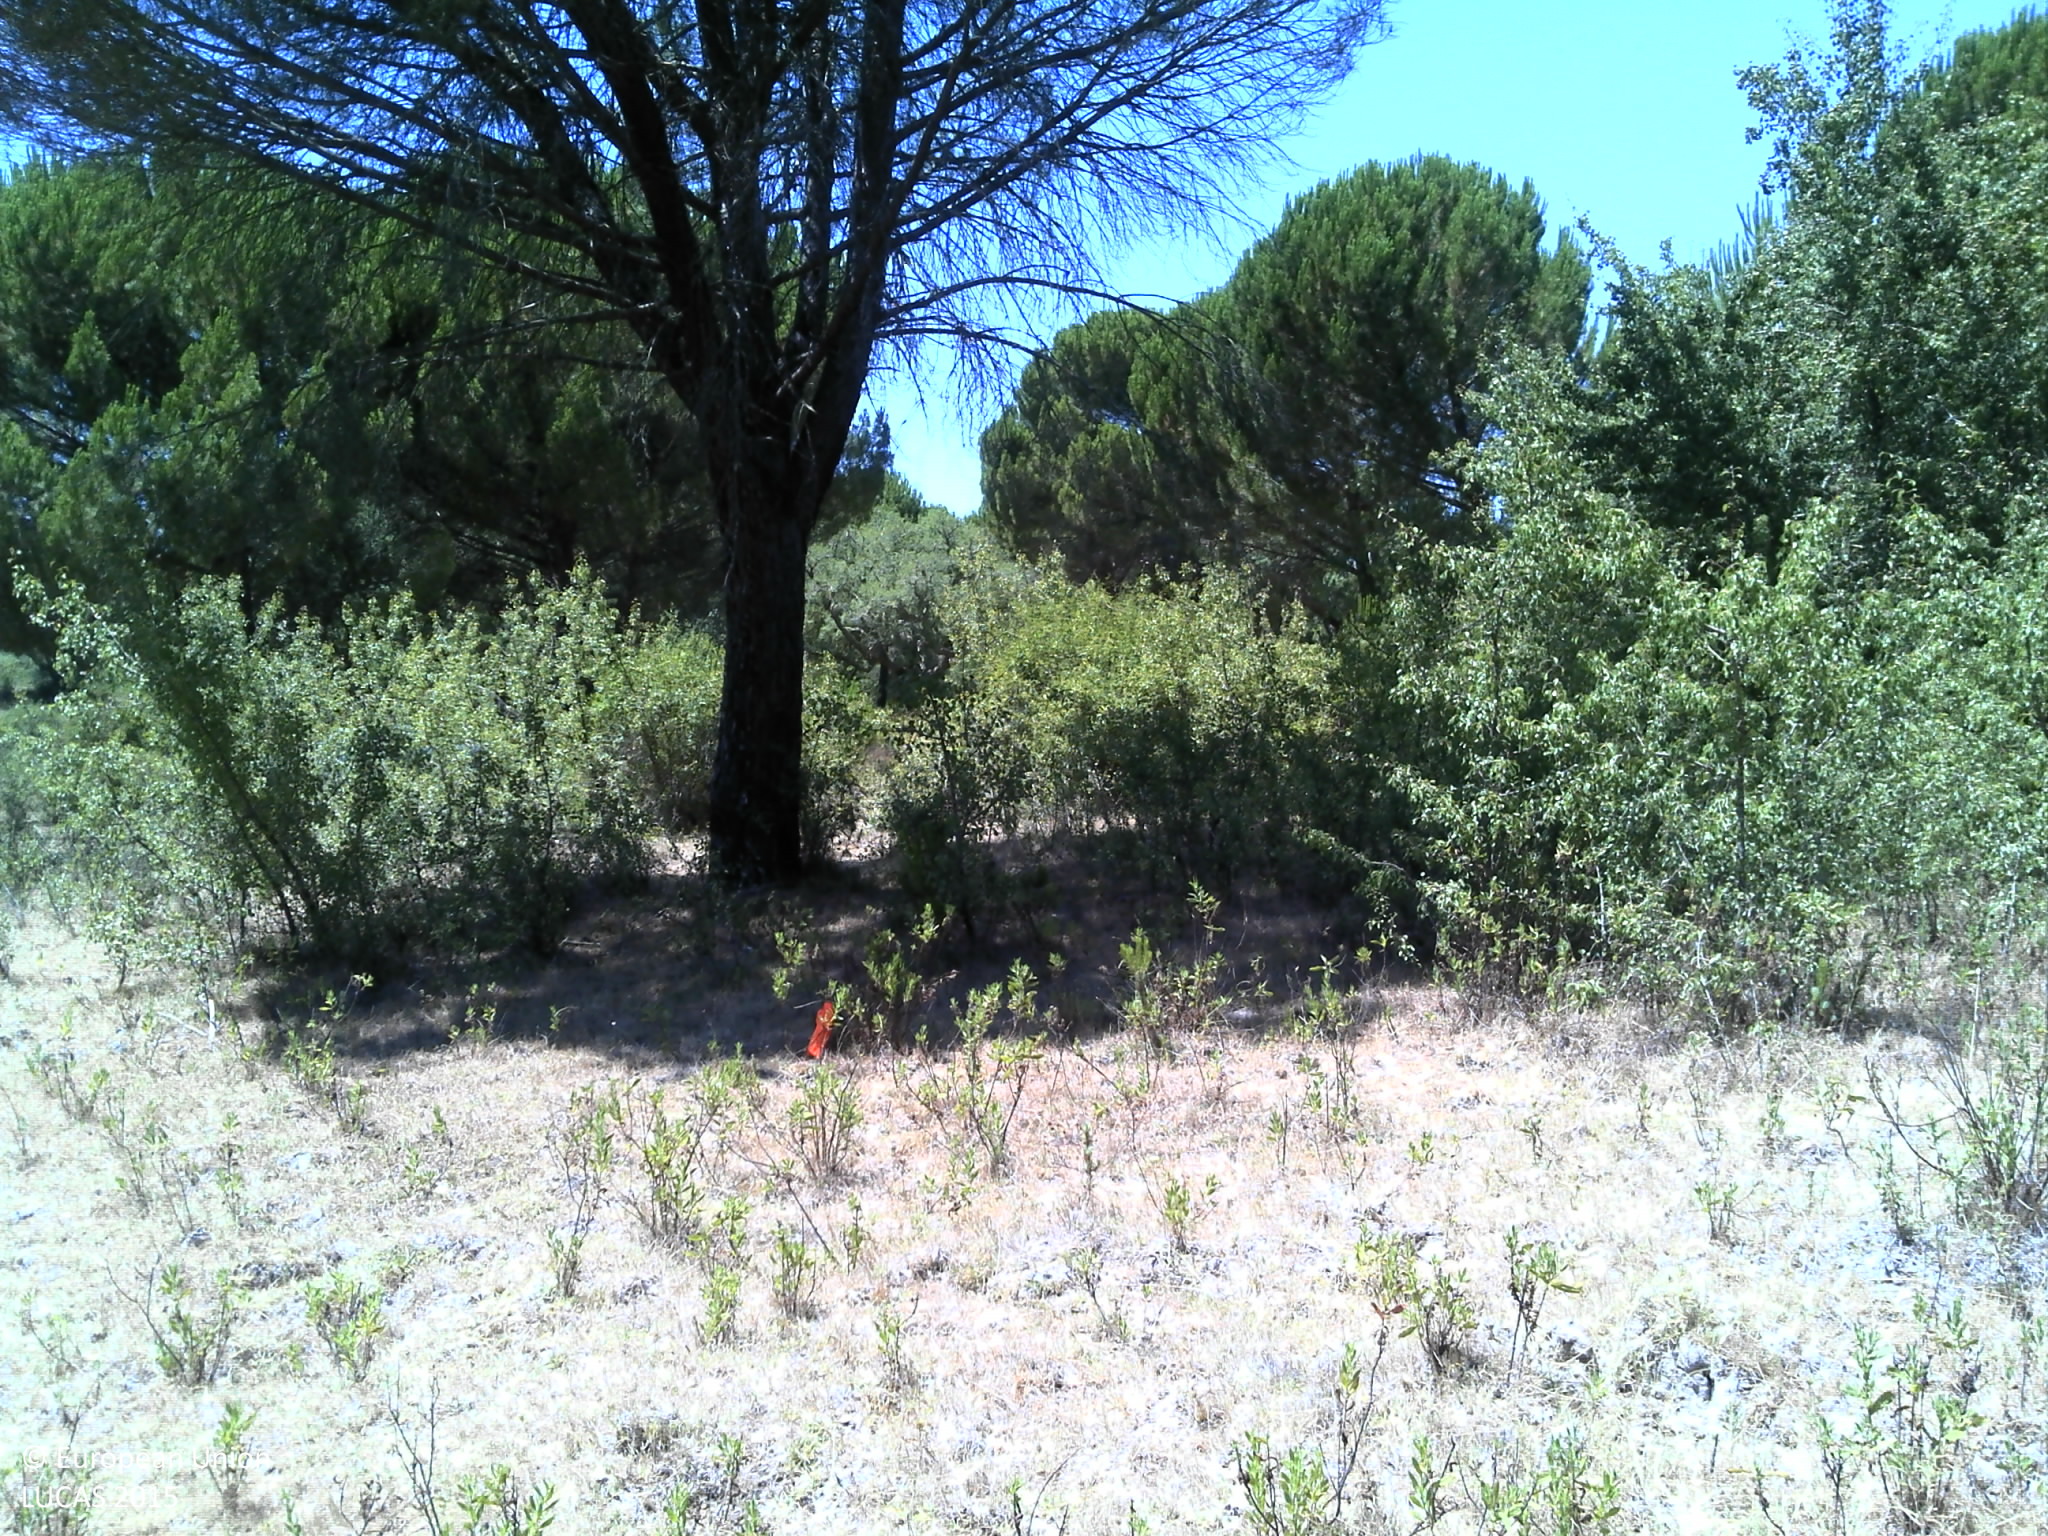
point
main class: Woodland
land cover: Pine dominated mixed woodland
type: coniferous forest of the mediterranean region
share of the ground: 10 - 25 %
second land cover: Shrubland without tree cover
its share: 10 - 25 %
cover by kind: herbaceous plants 30 %, unconsolidated bare surface 30 %, coniferous forest trees 15 %, shrubs 15 %, broadleaved forest trees 10 %
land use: Forestry
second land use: Agriculture (excluding fallow land and kitchen gardens)
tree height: > 5 m
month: July
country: PT
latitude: 38.5738
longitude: -8.5470
